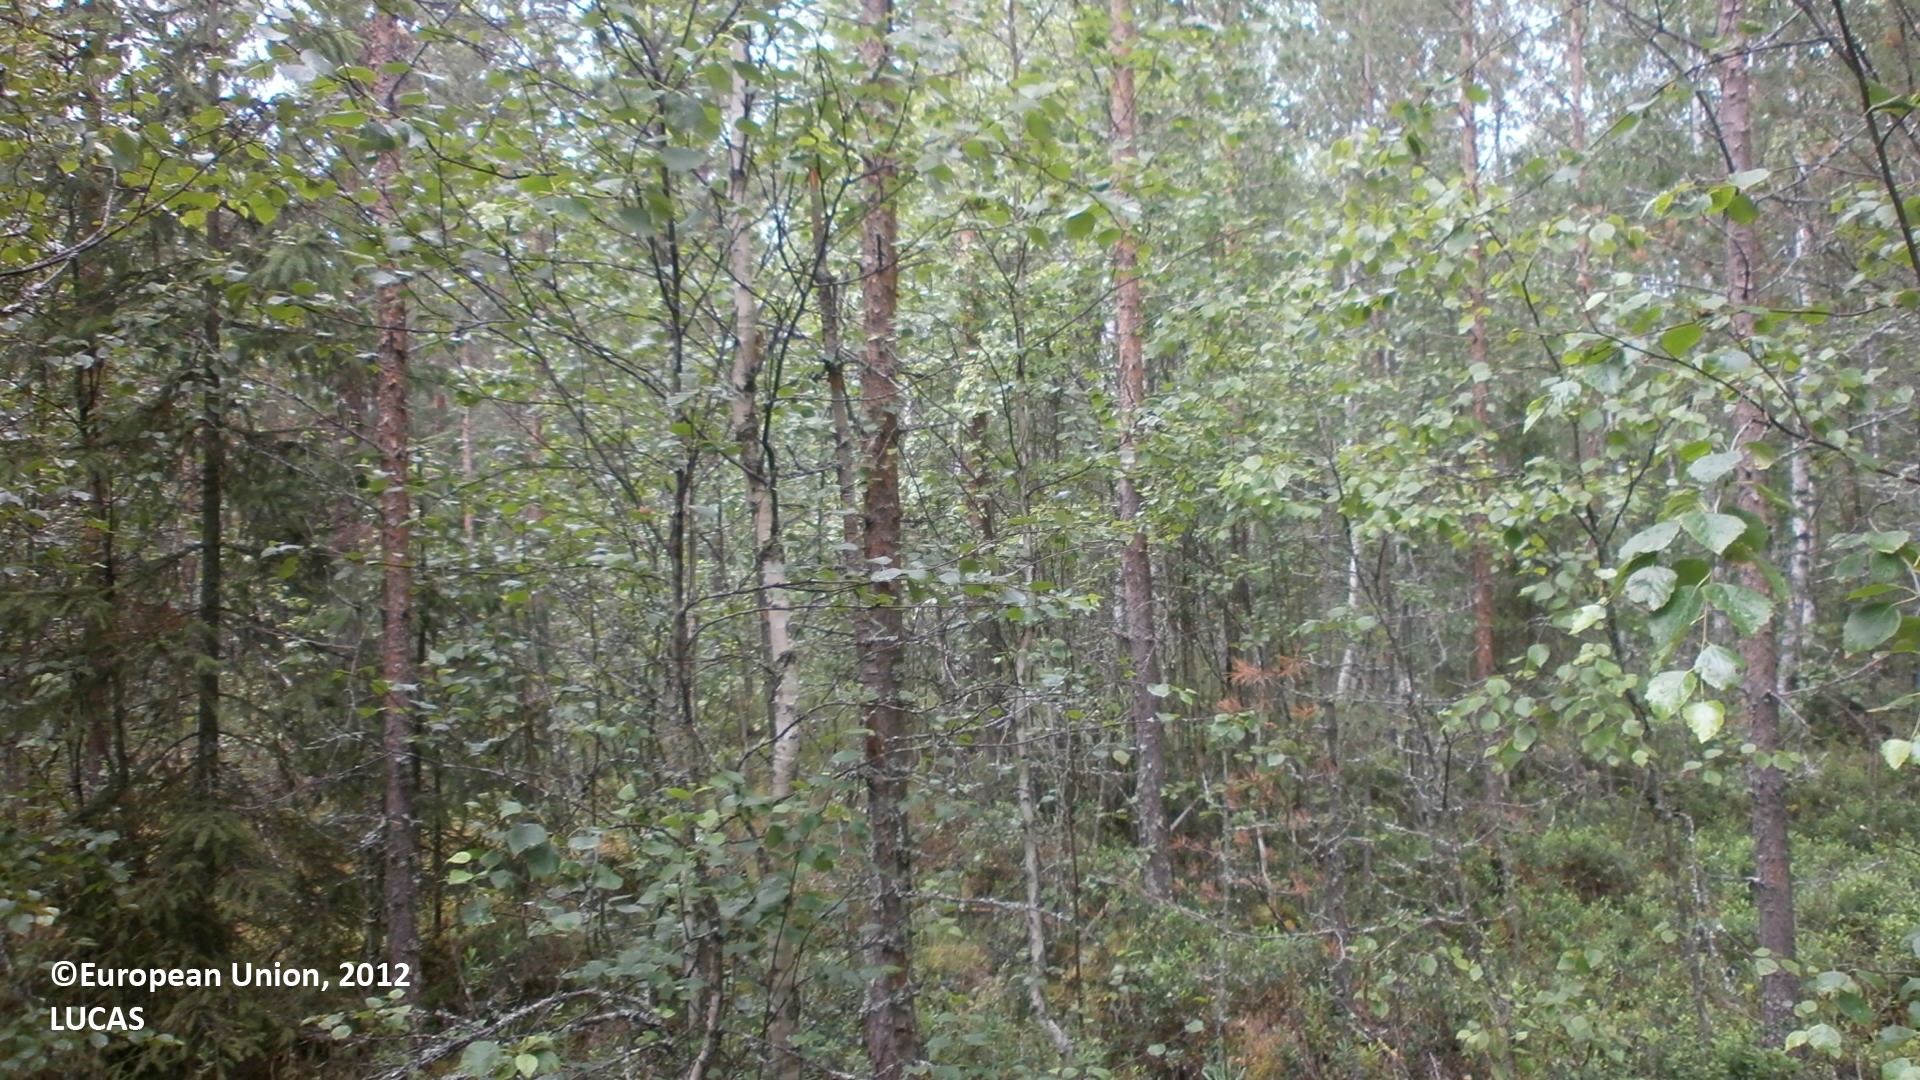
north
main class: Woodland
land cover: Pine dominated mixed woodland
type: boreal forest
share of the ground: 50 - 75 %
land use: Forestry
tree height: > 5 m
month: July
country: FI
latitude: 64.2694
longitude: 24.4183
